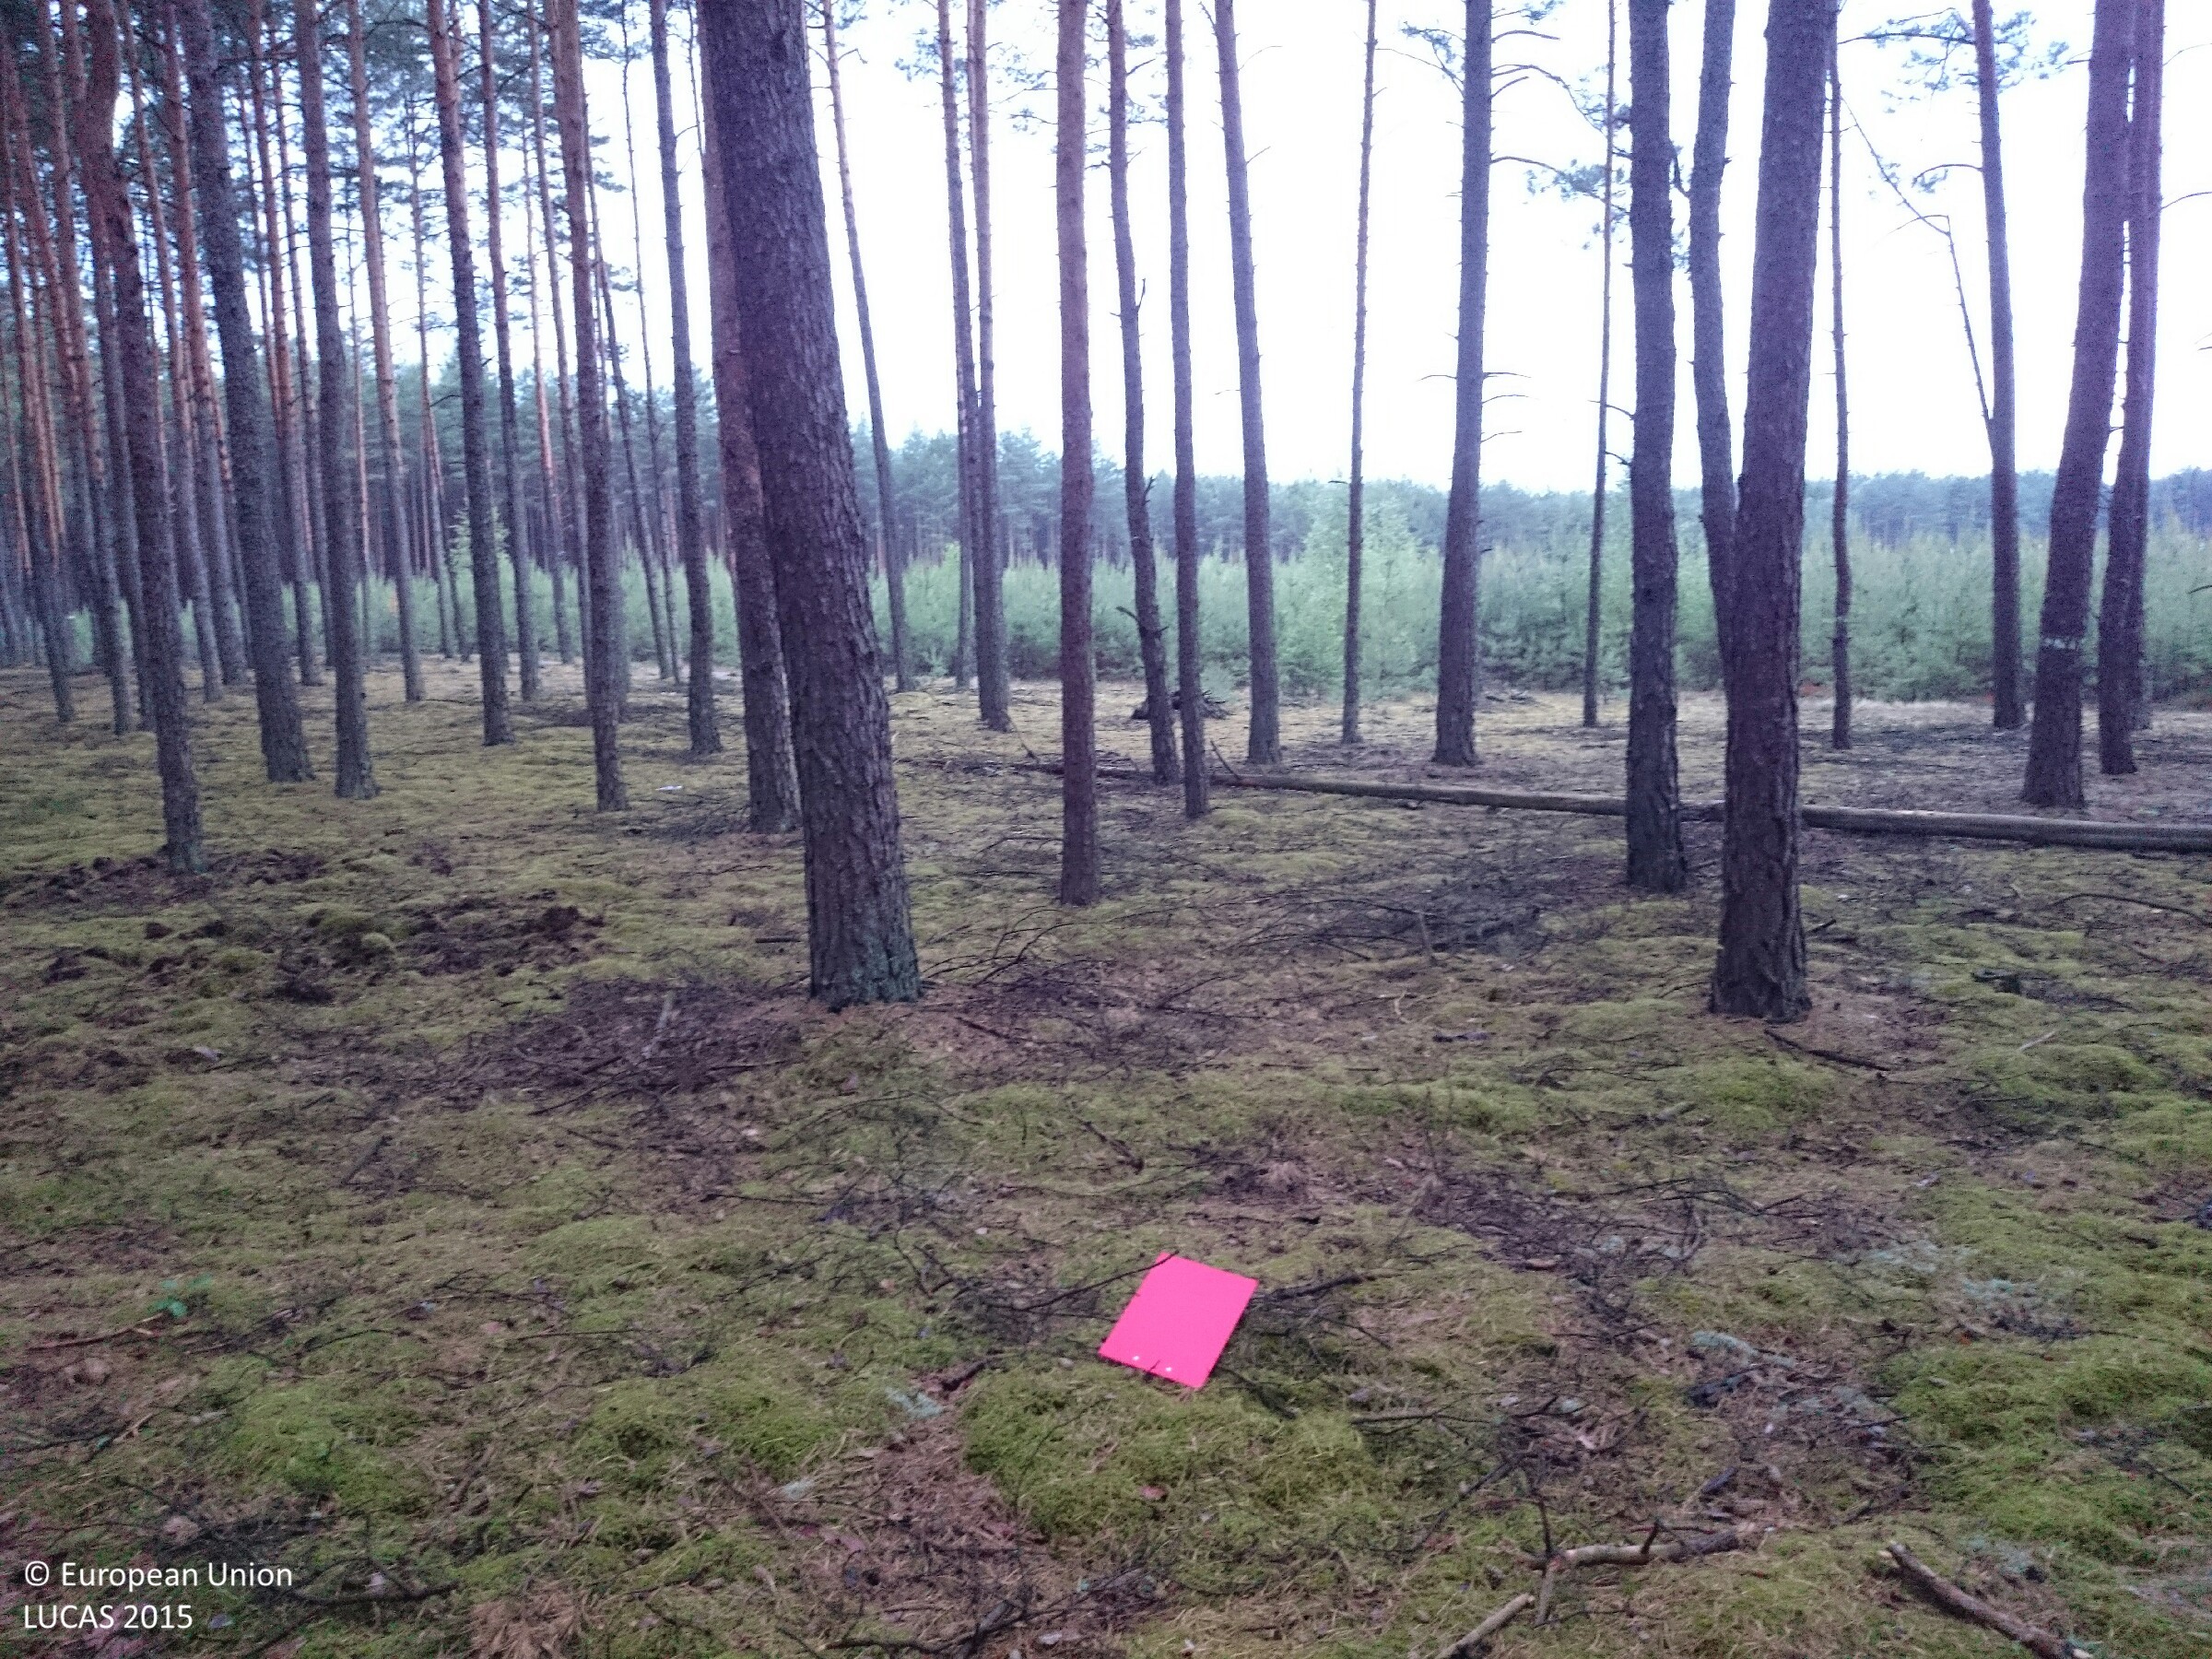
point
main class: Woodland
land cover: Pine dominated coniferous woodland
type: hemiboreal forest and nemoral coniferous forest and mixed broadleaved-coniferous forest
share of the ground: > 75 %
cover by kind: coniferous forest trees 100 %
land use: Forestry
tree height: > 5 m
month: June
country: PL
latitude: 52.7283
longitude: 15.6757
